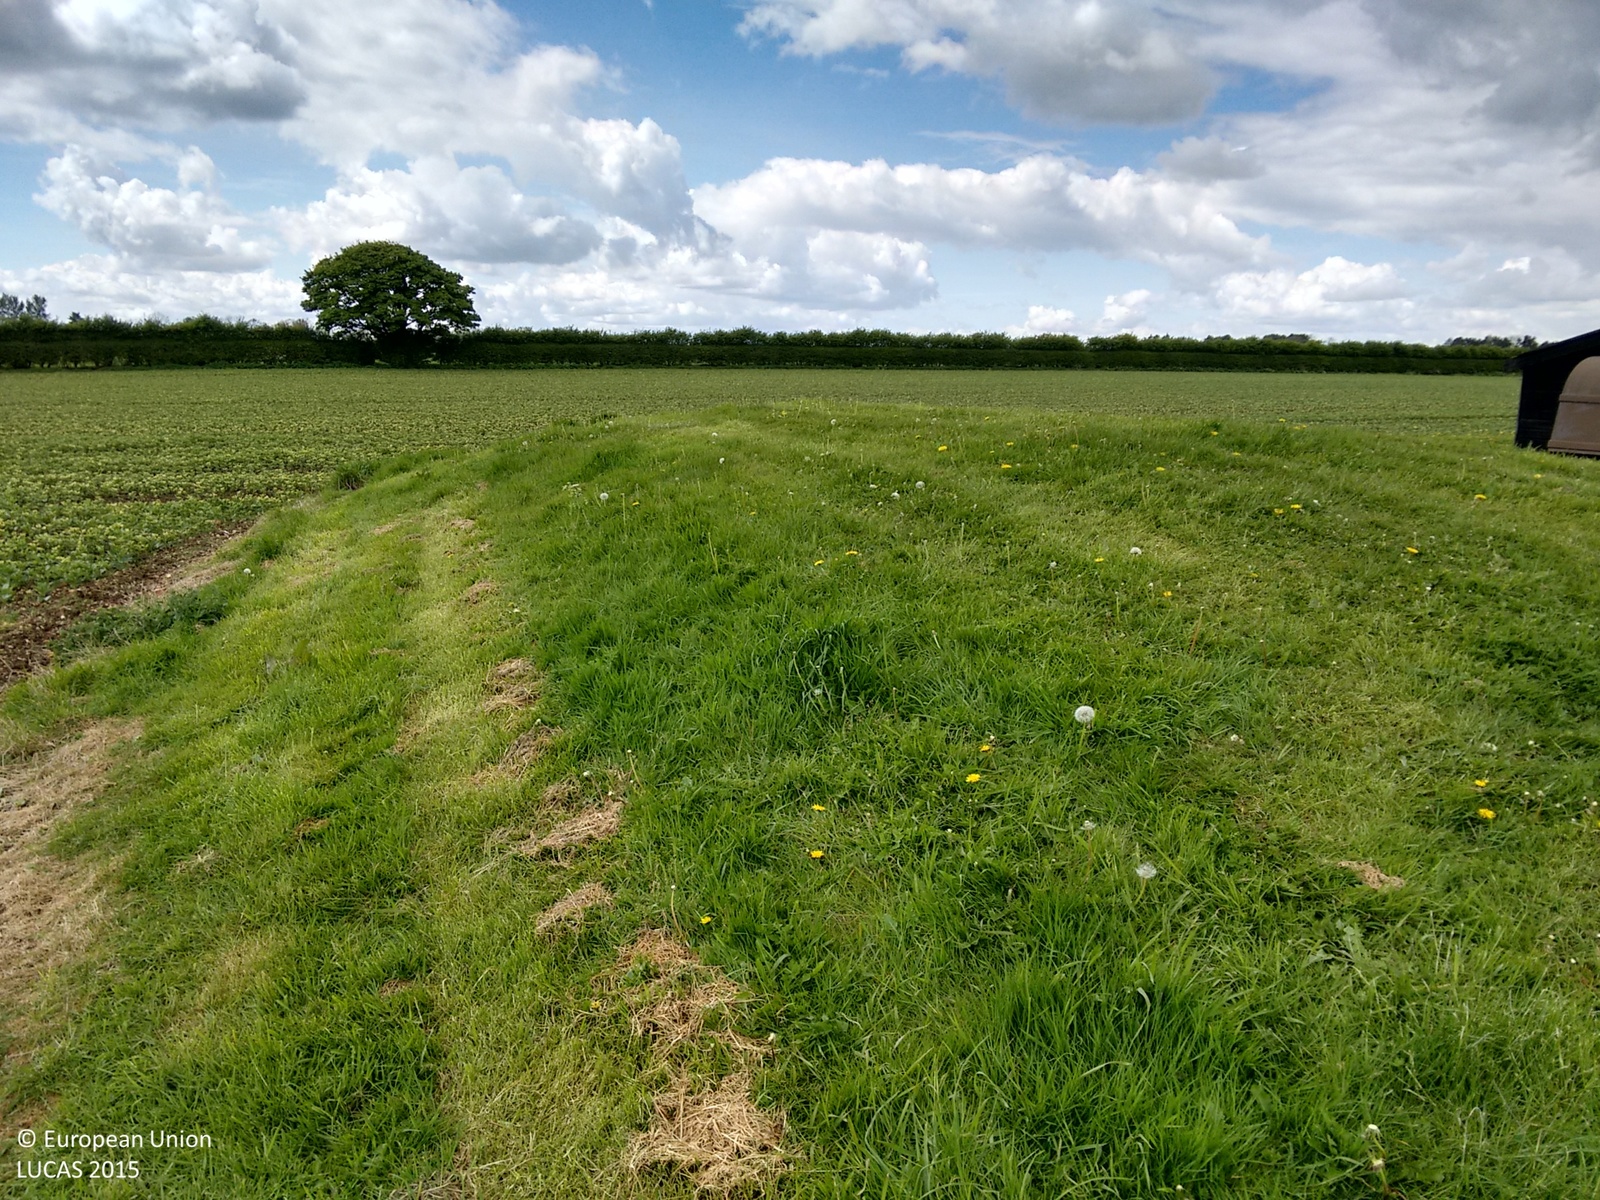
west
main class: Grassland
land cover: Grassland without tree/shrub cover
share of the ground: > 75 %
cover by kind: herbaceous plants 100 %
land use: Agriculture (excluding fallow land and kitchen gardens)
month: May
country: GB
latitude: 53.3860
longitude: -0.2129
